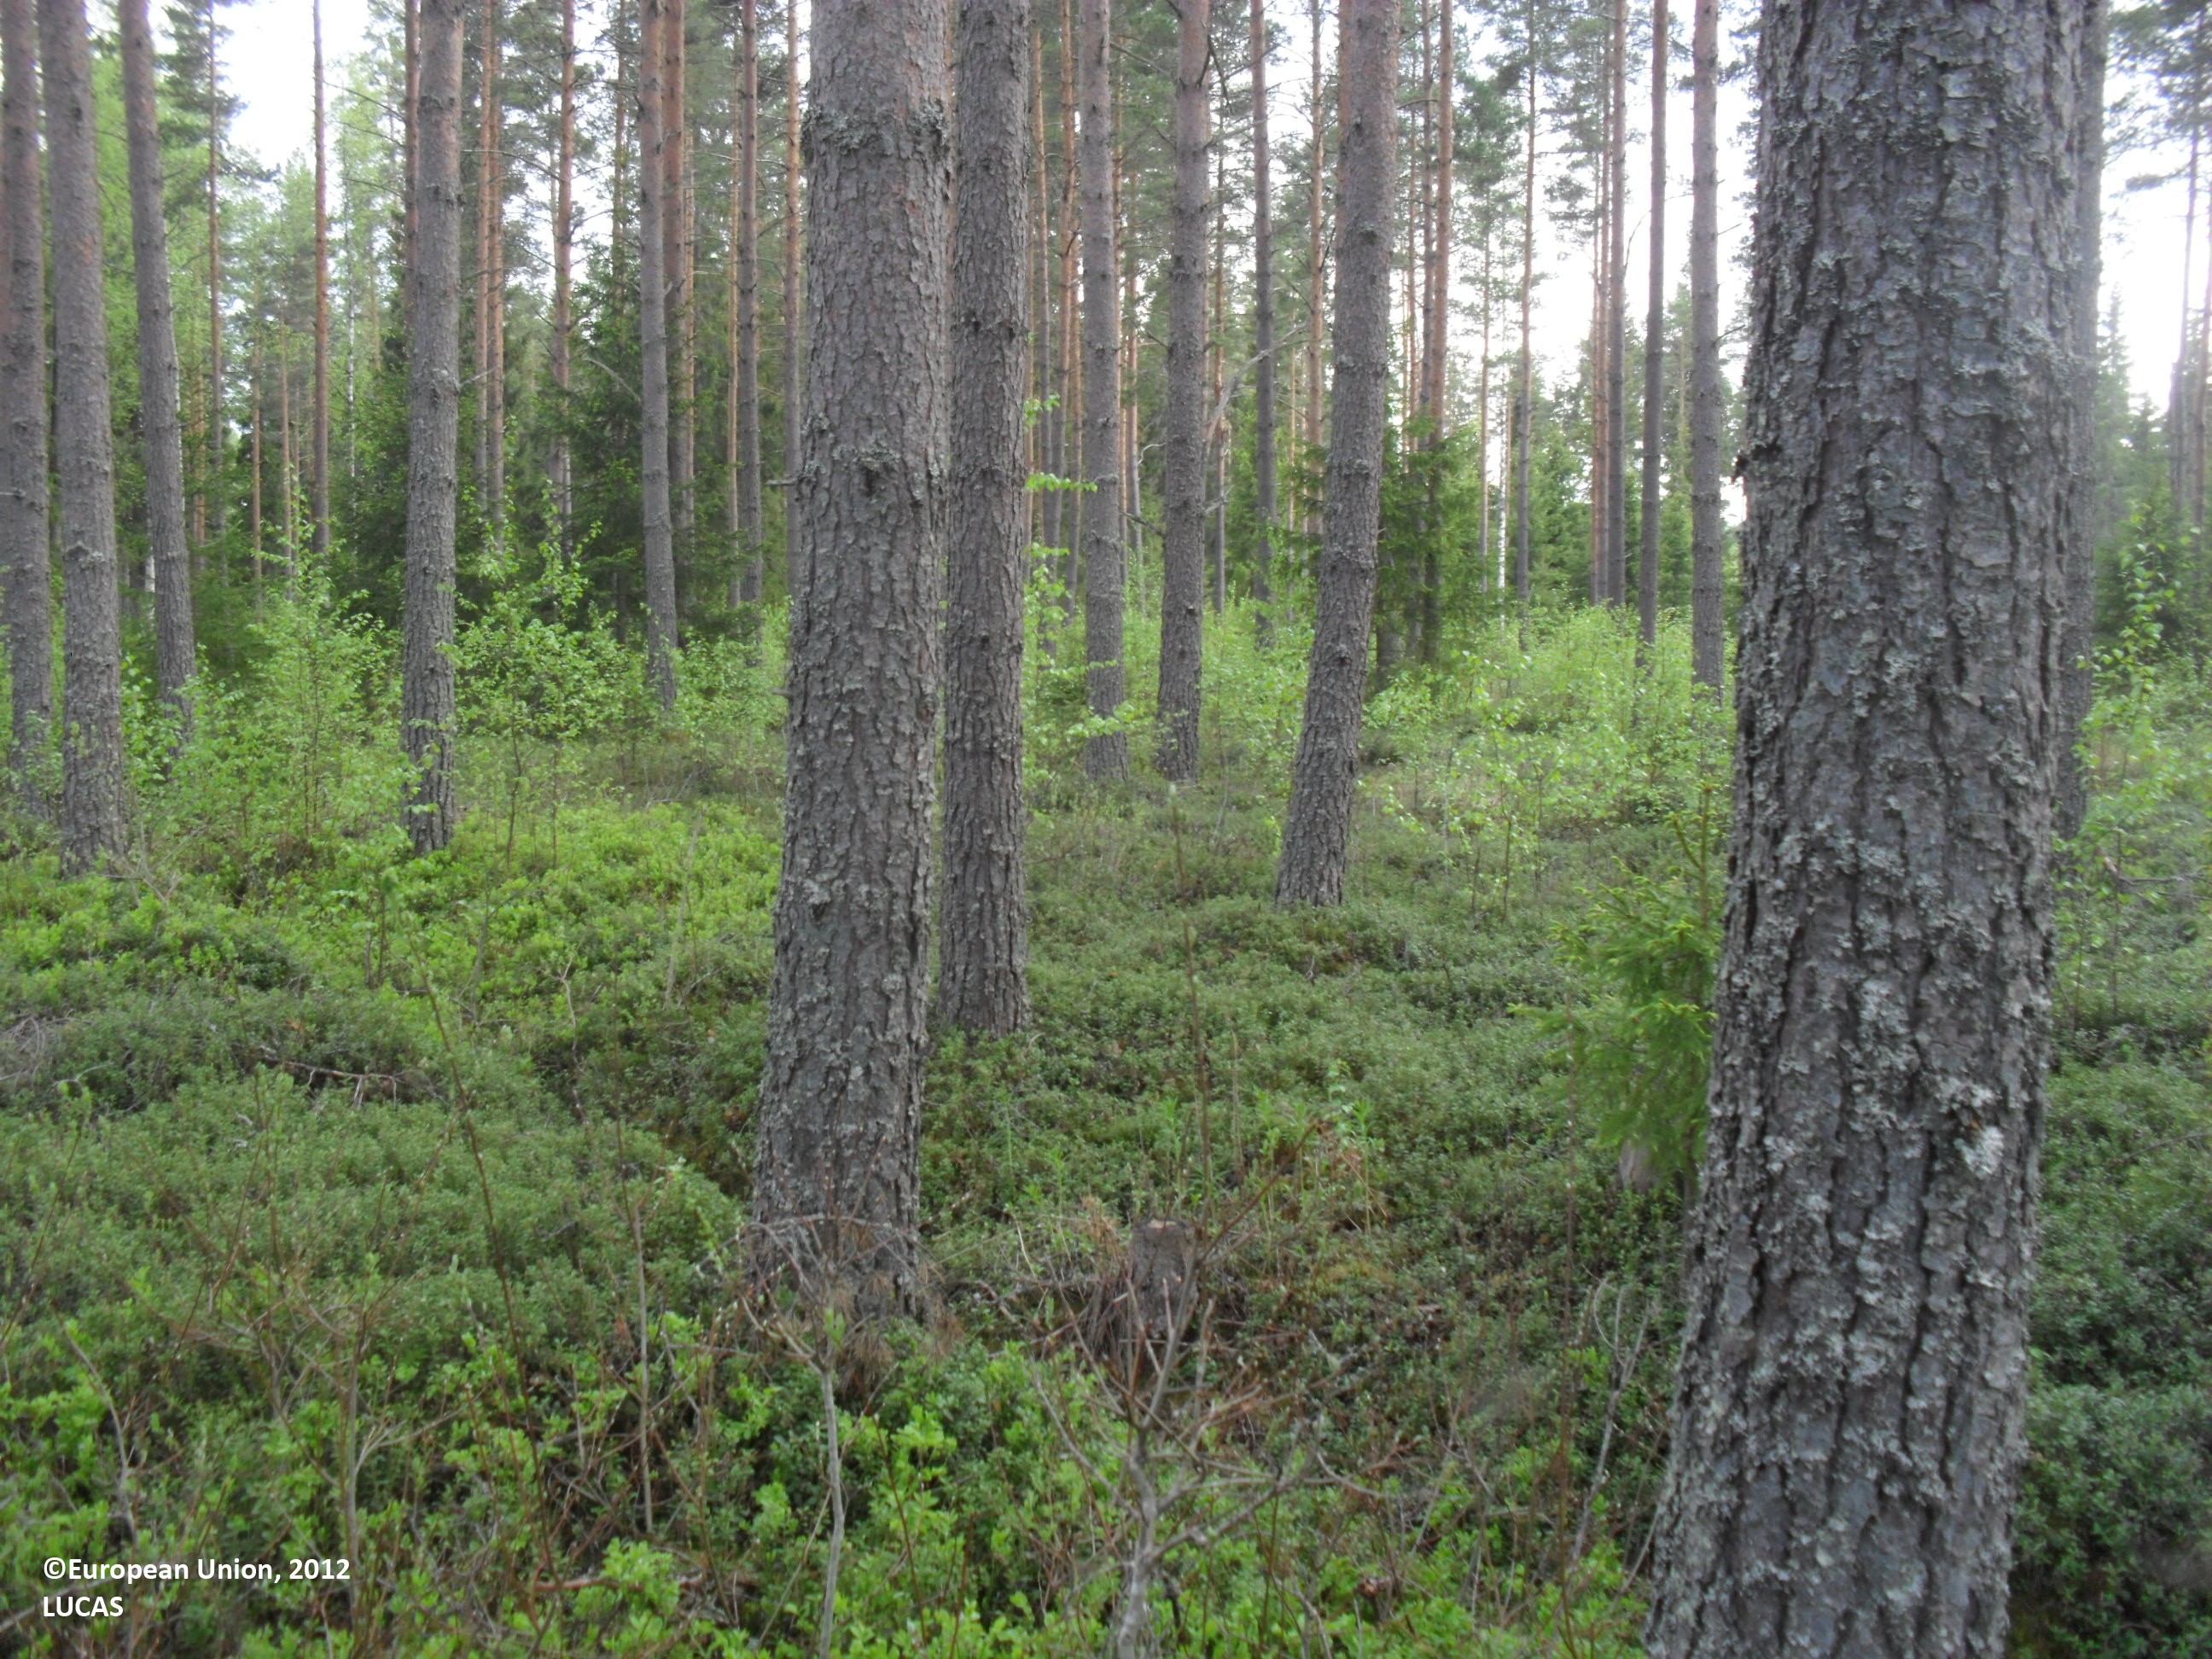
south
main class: Woodland
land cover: Pine dominated mixed woodland
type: boreal forest
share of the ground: 50 - 75 %
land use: Forestry
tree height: > 5 m
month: June
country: FI
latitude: 62.8281
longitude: 23.2744
